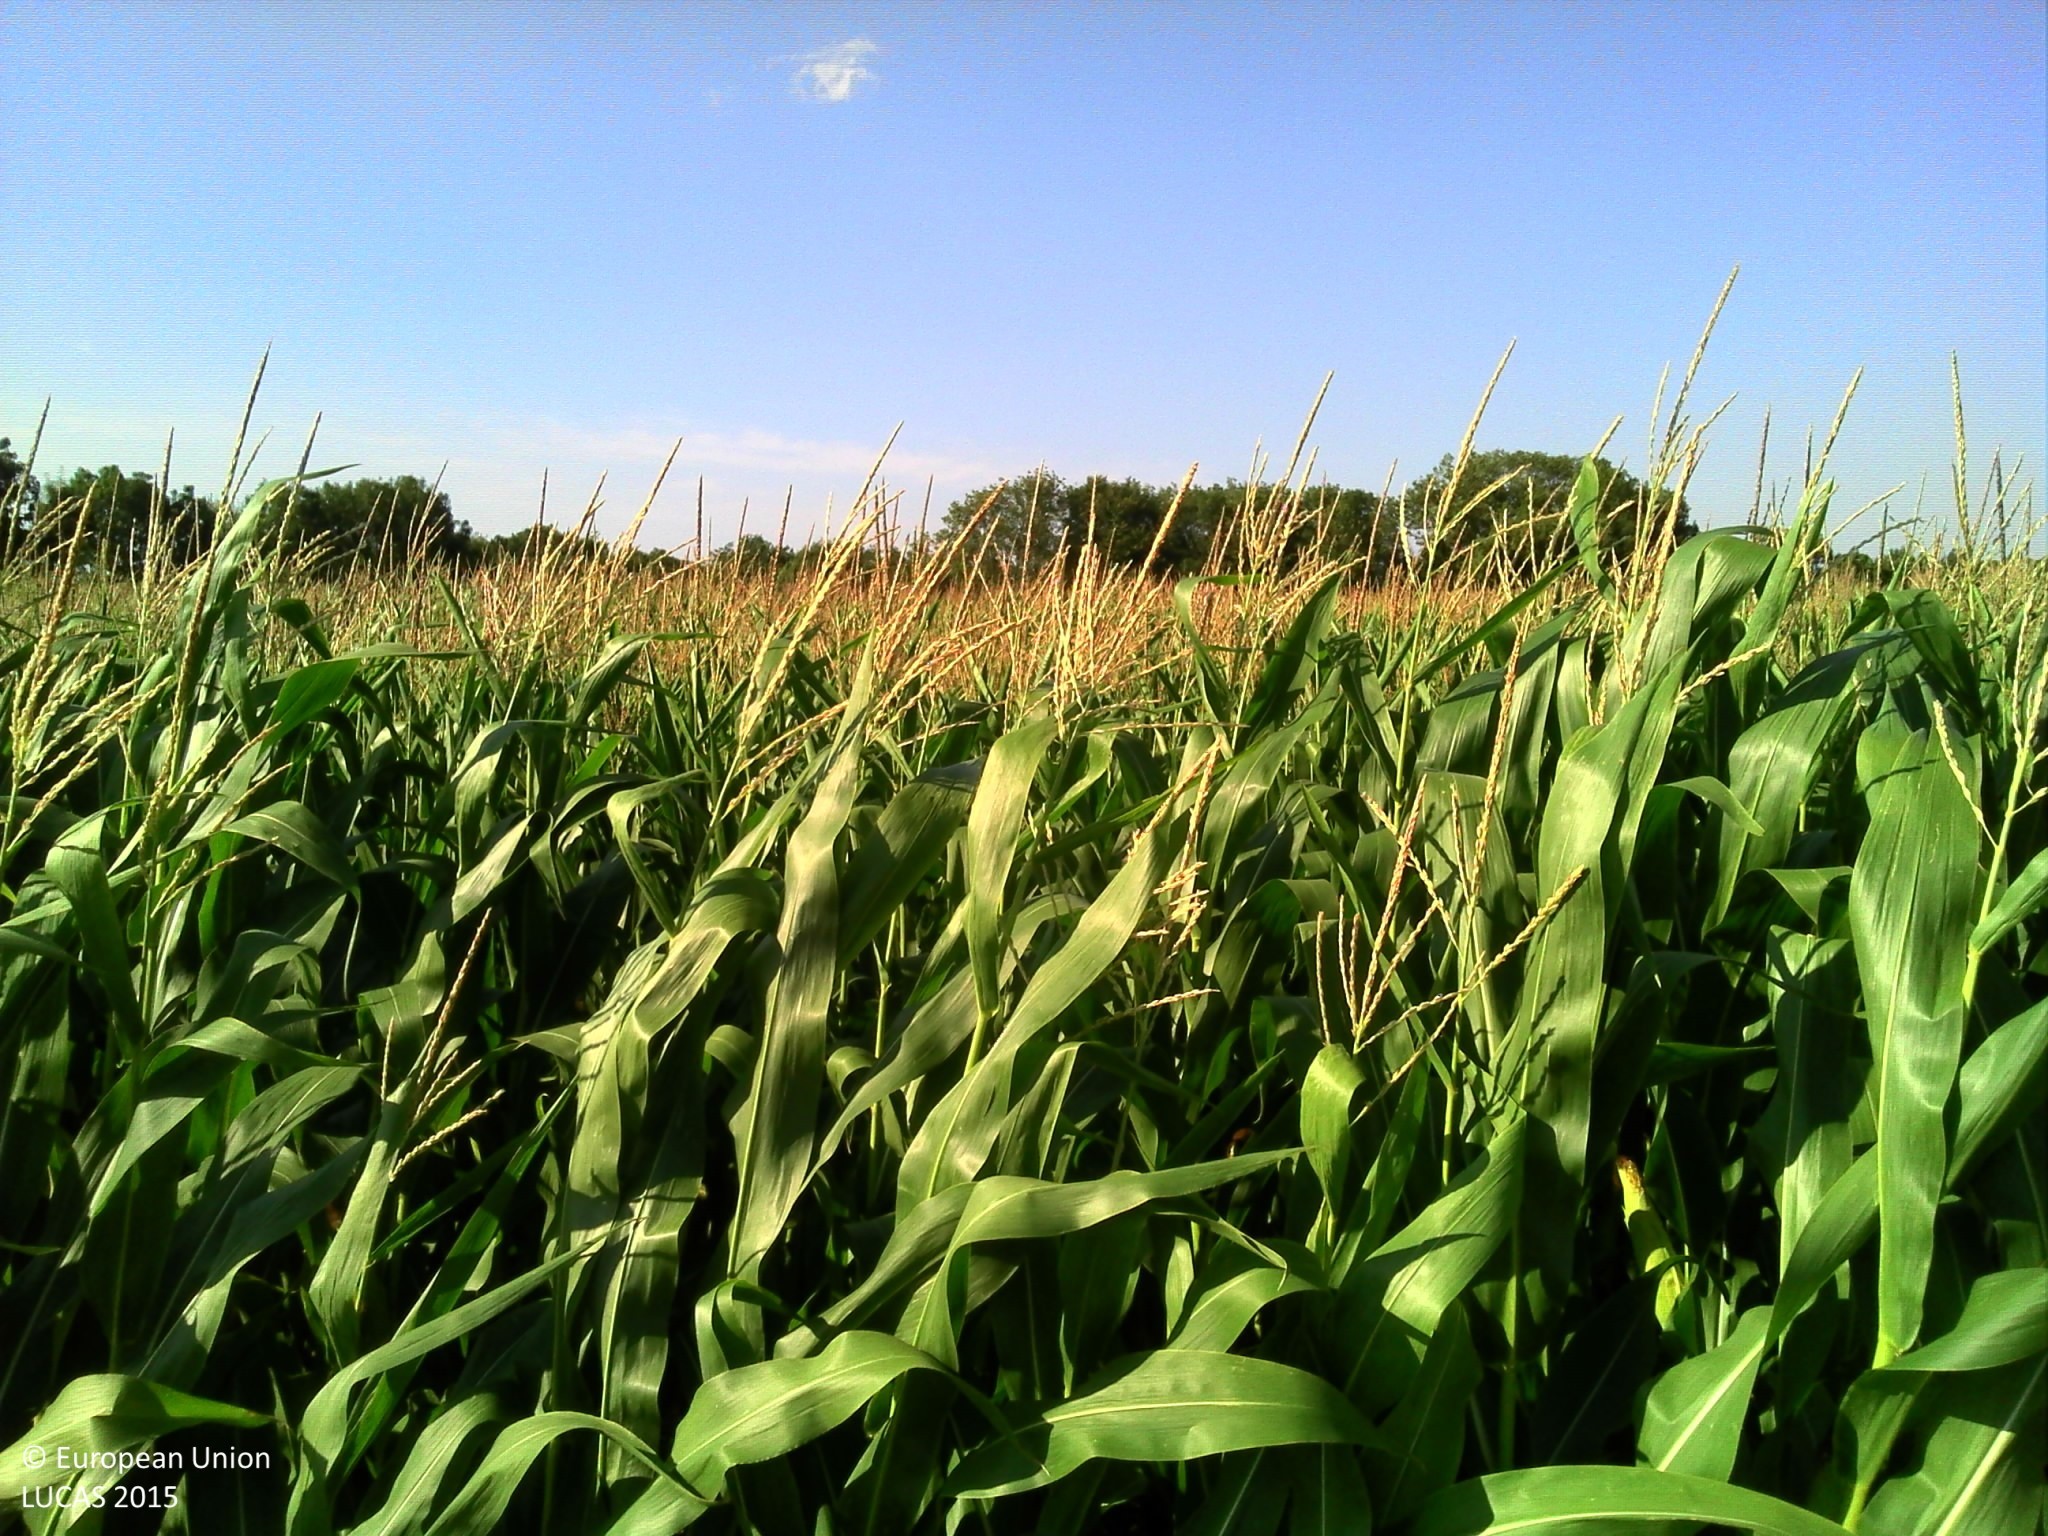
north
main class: Cropland
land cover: Maize
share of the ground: > 75 %
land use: Agriculture (excluding fallow land and kitchen gardens)
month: August
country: FR
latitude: 45.5151
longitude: 5.4602
